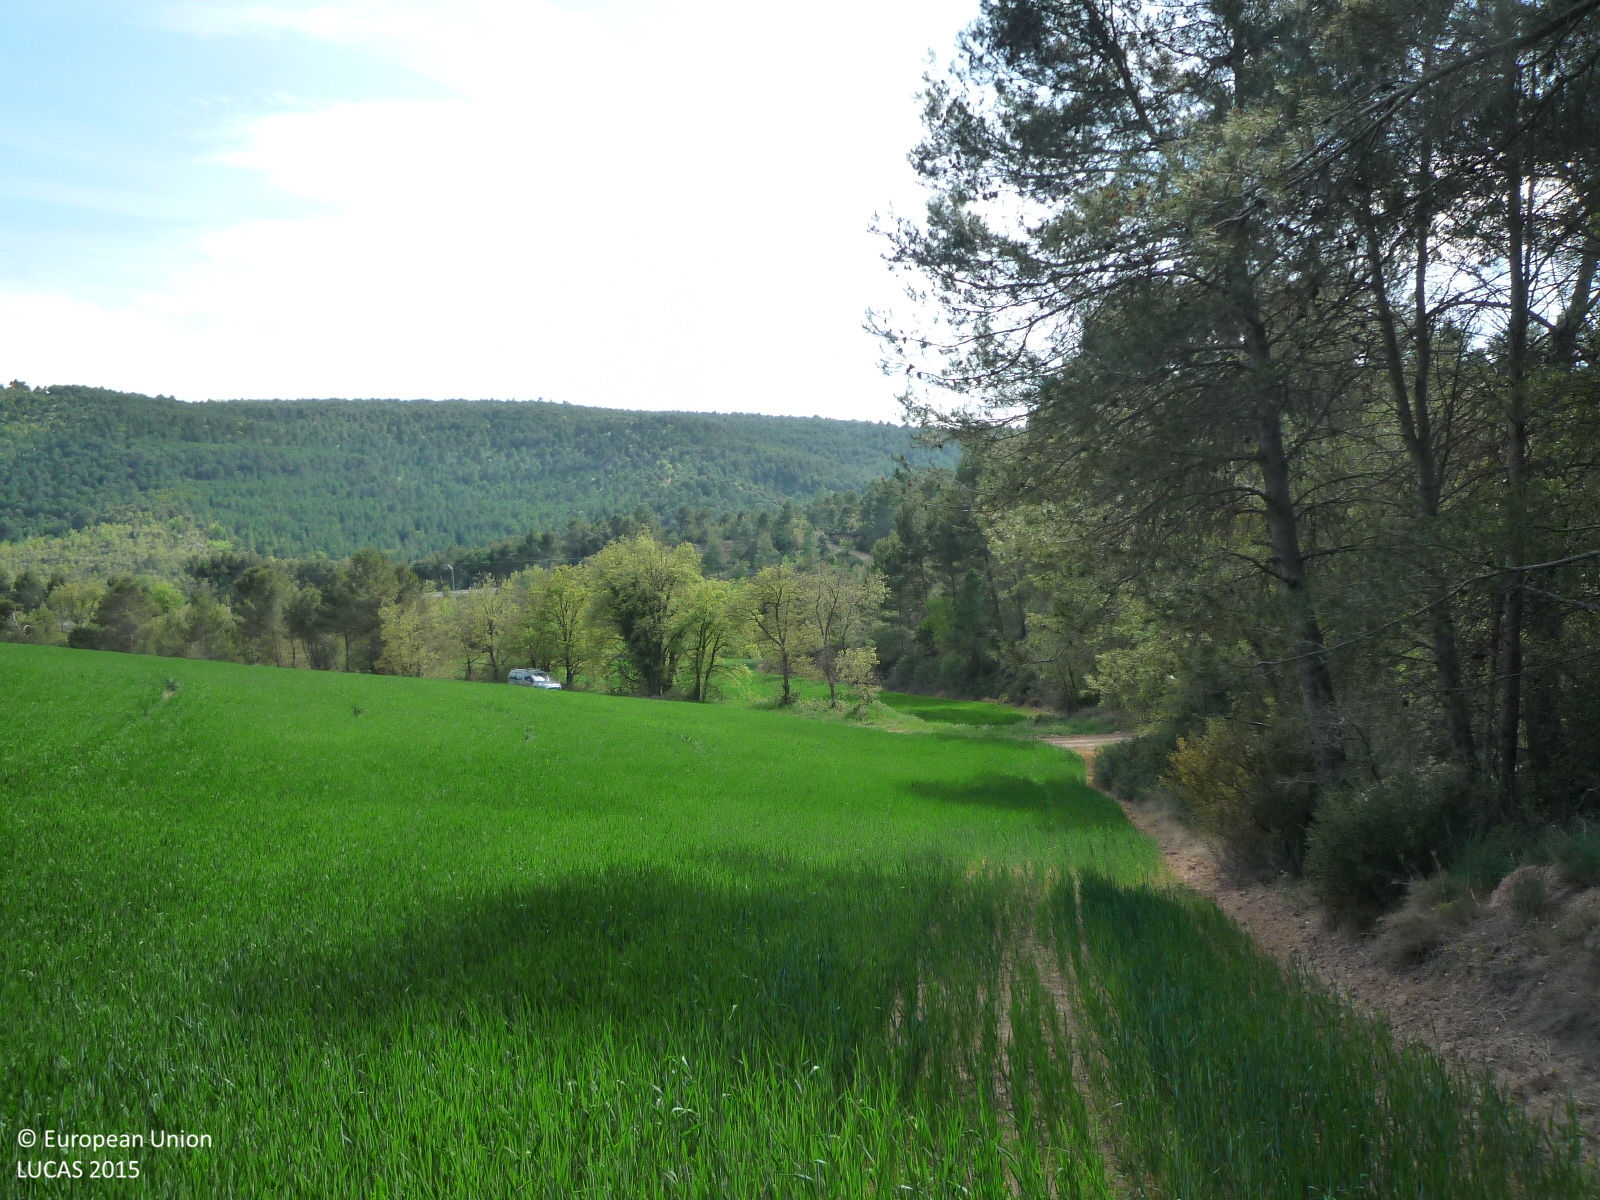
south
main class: Cropland
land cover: Durum wheat
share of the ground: > 75 %
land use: Agriculture (excluding fallow land and kitchen gardens)
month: April
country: ES
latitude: 41.7426
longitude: 1.6094
